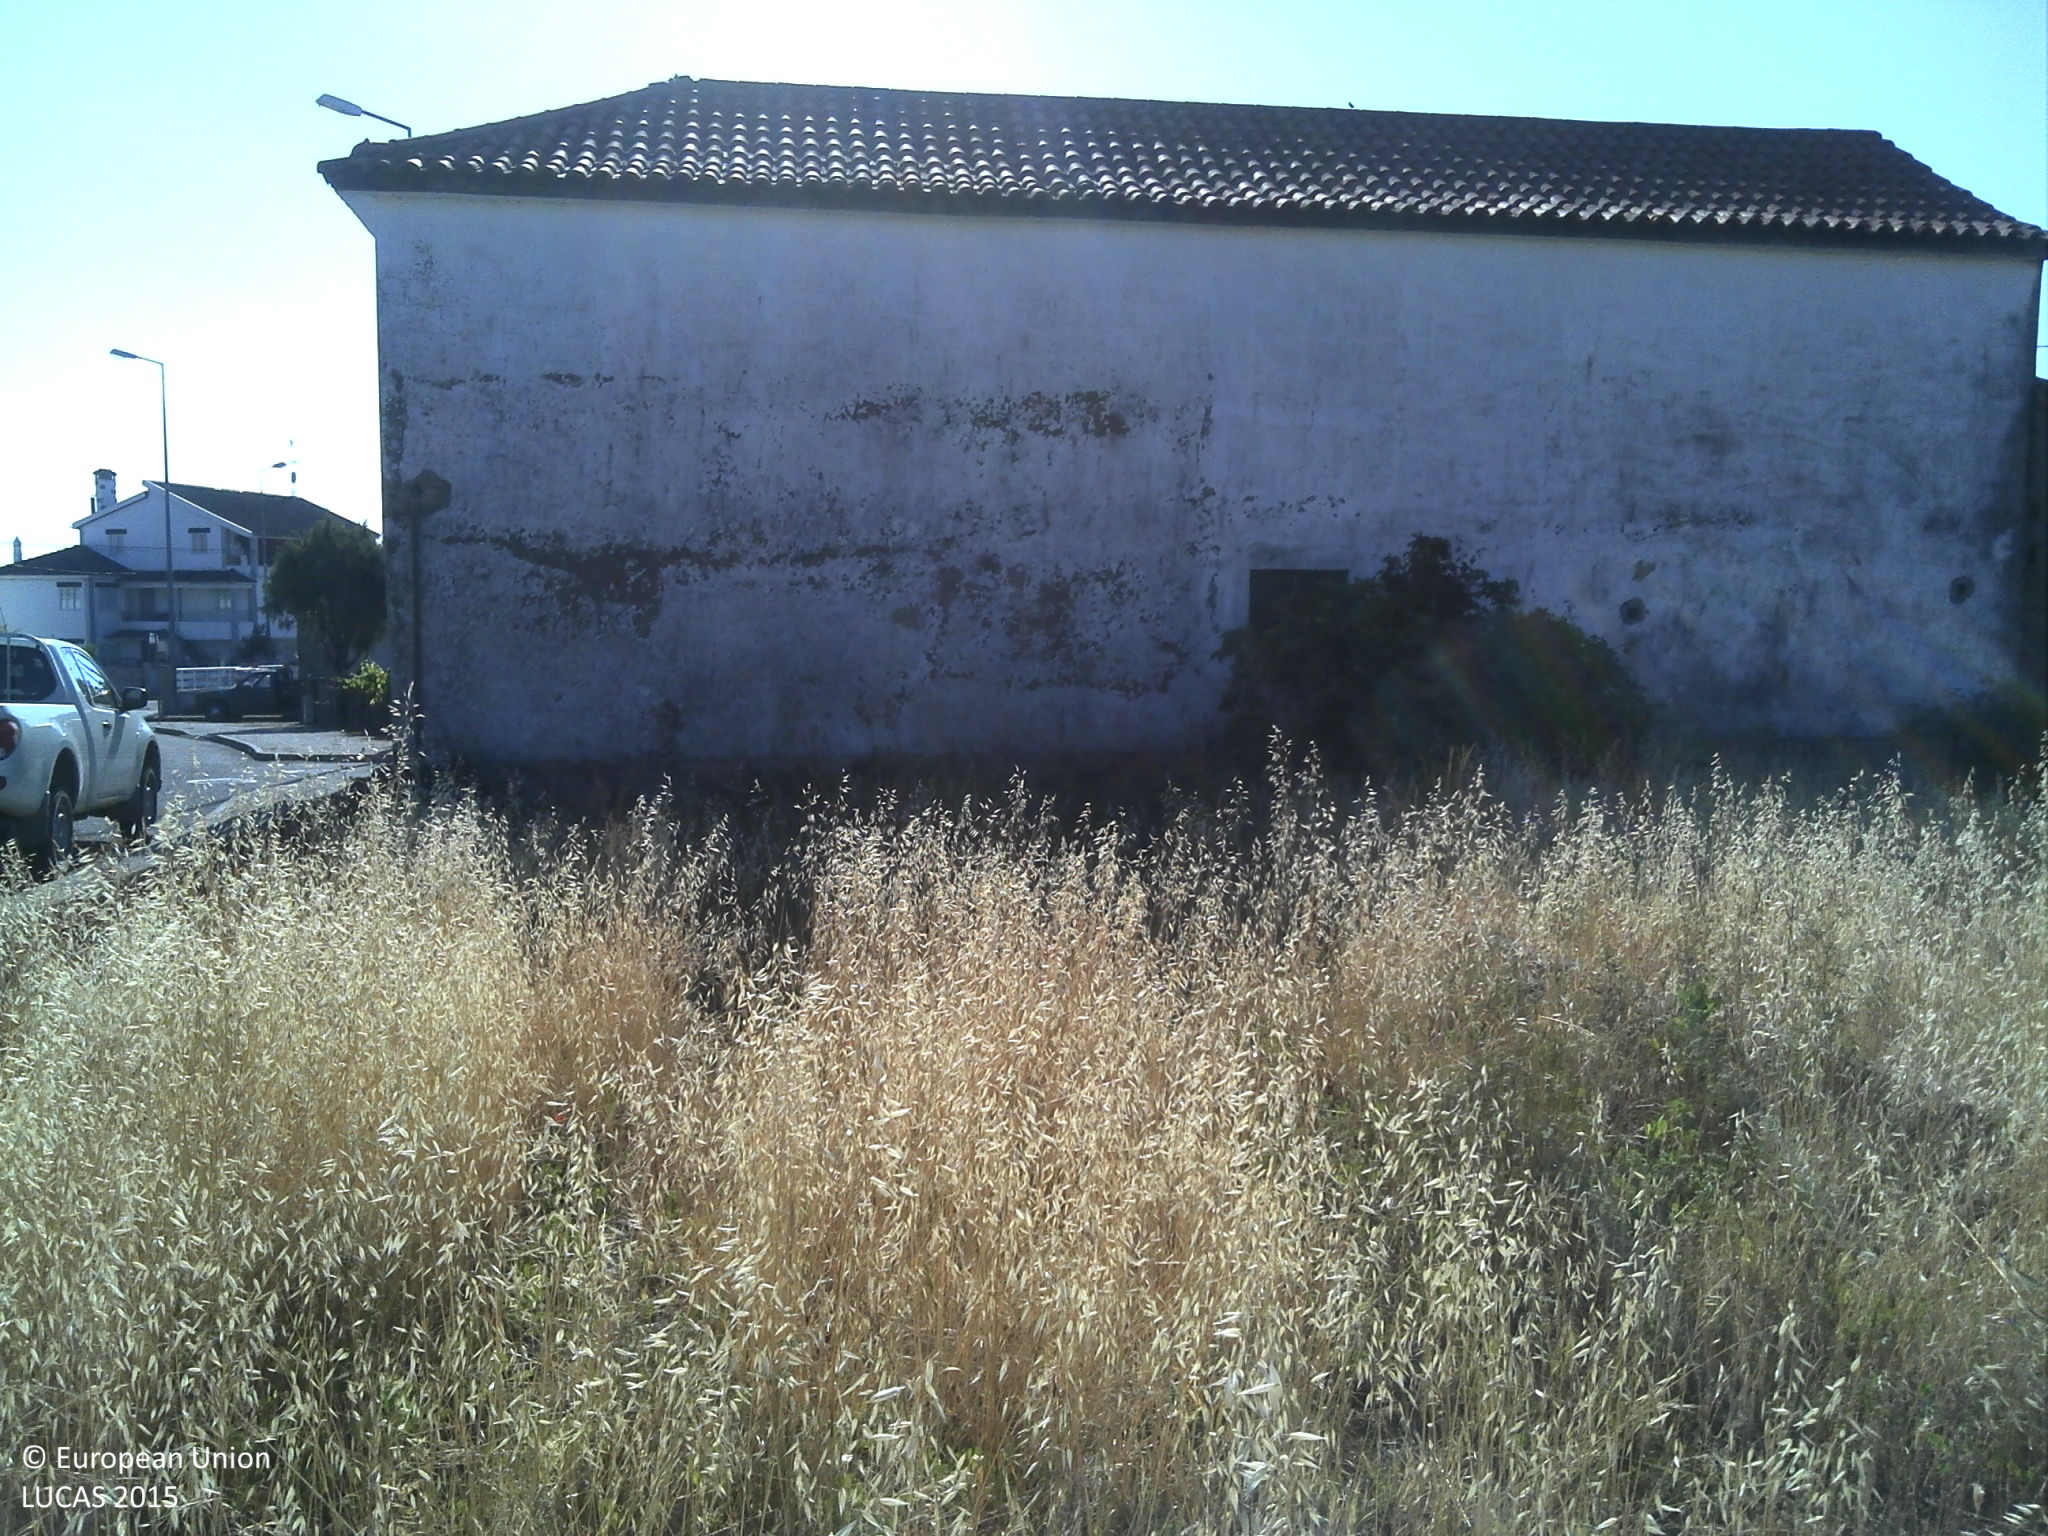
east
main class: Grassland
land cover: Spontaneously vegetated surfaces
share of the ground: > 75 %
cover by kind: herbaceous plants 100 %
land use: Fallow land
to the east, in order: Spontaneously vegetated surfaces; Artificial constructions in urban areas; Single bushes/trees; Shruby margins; Tracks; Shruby margins; Spontaneously vegetated surfaces; Electric lines; Spontaneously vegetated surfaces; Shruby margins; Dry stone walls; Spontaneously vegetated surfaces
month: June
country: PT
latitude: 40.7245
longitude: -6.9001
